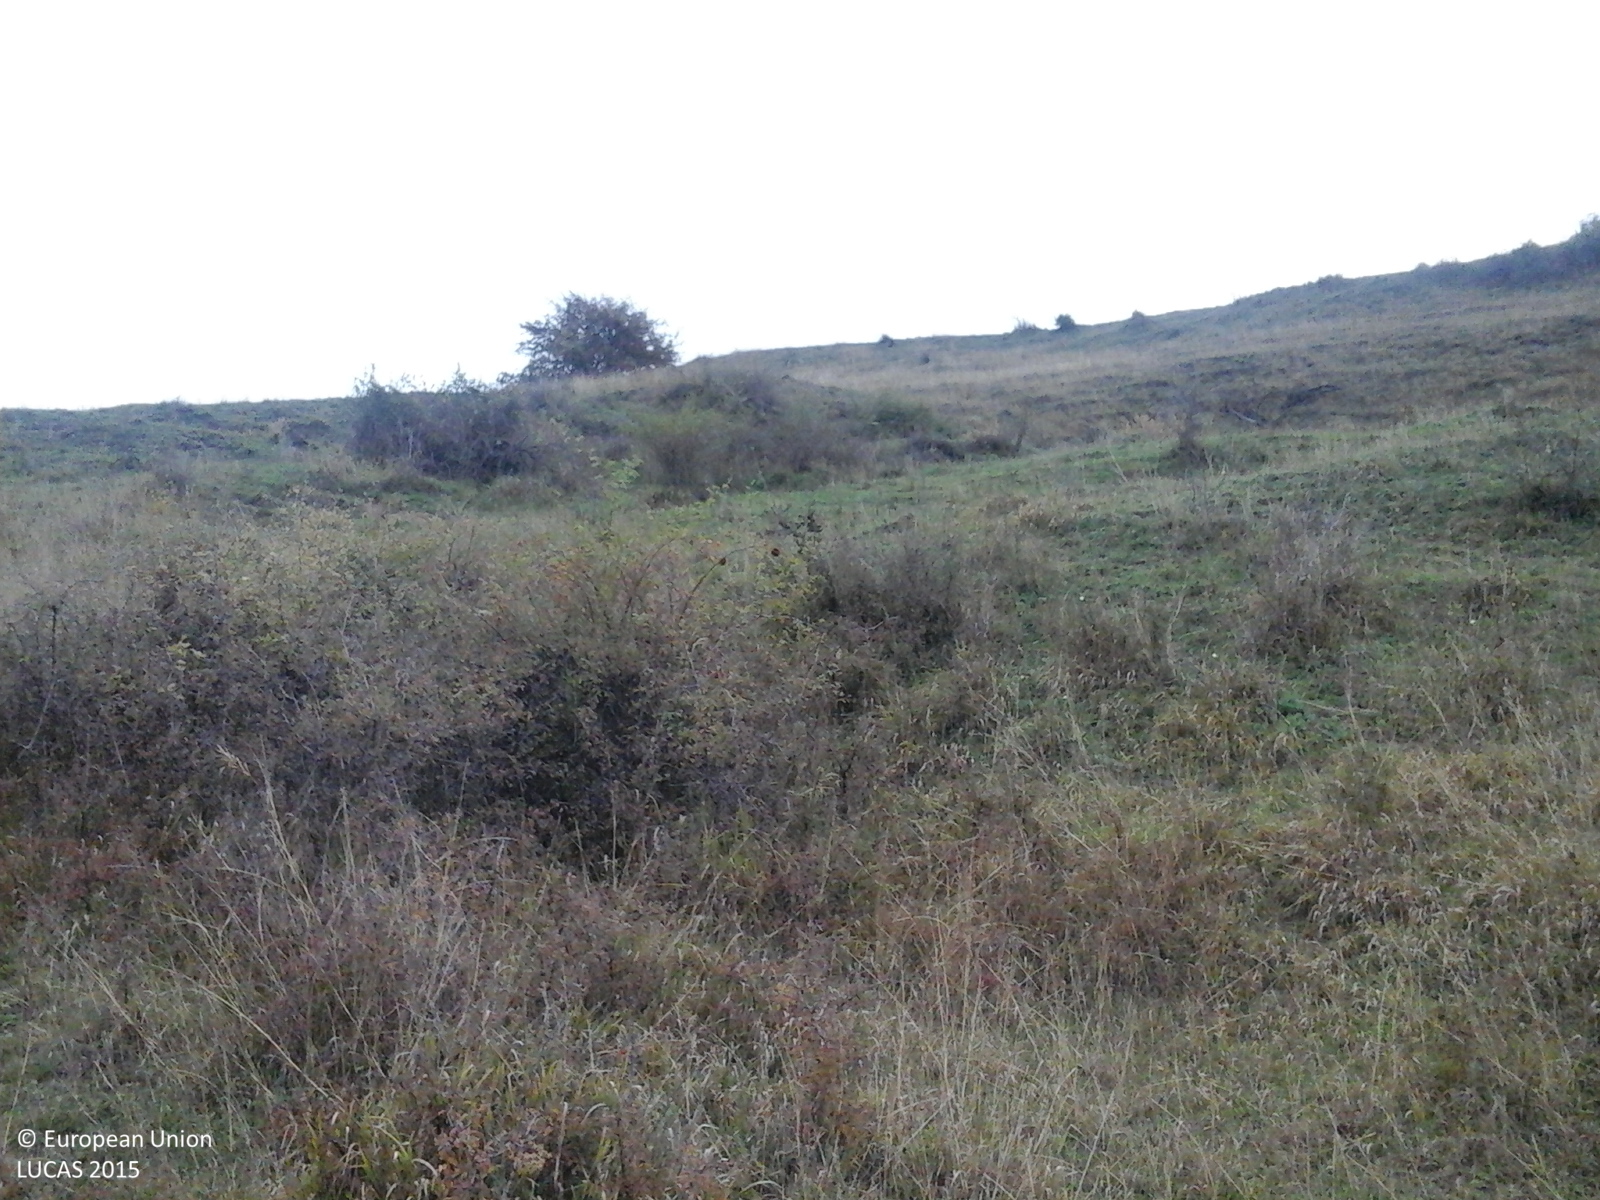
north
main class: Grassland
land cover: Grassland with sparse tree/shrub cover
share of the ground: > 75 %
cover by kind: herbaceous plants 85 %, shrubs 10 %, broadleaved forest trees 5 %
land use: Agriculture (excluding fallow land and kitchen gardens)
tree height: < 5 m
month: October
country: RO
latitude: 46.0518
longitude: 24.2306
